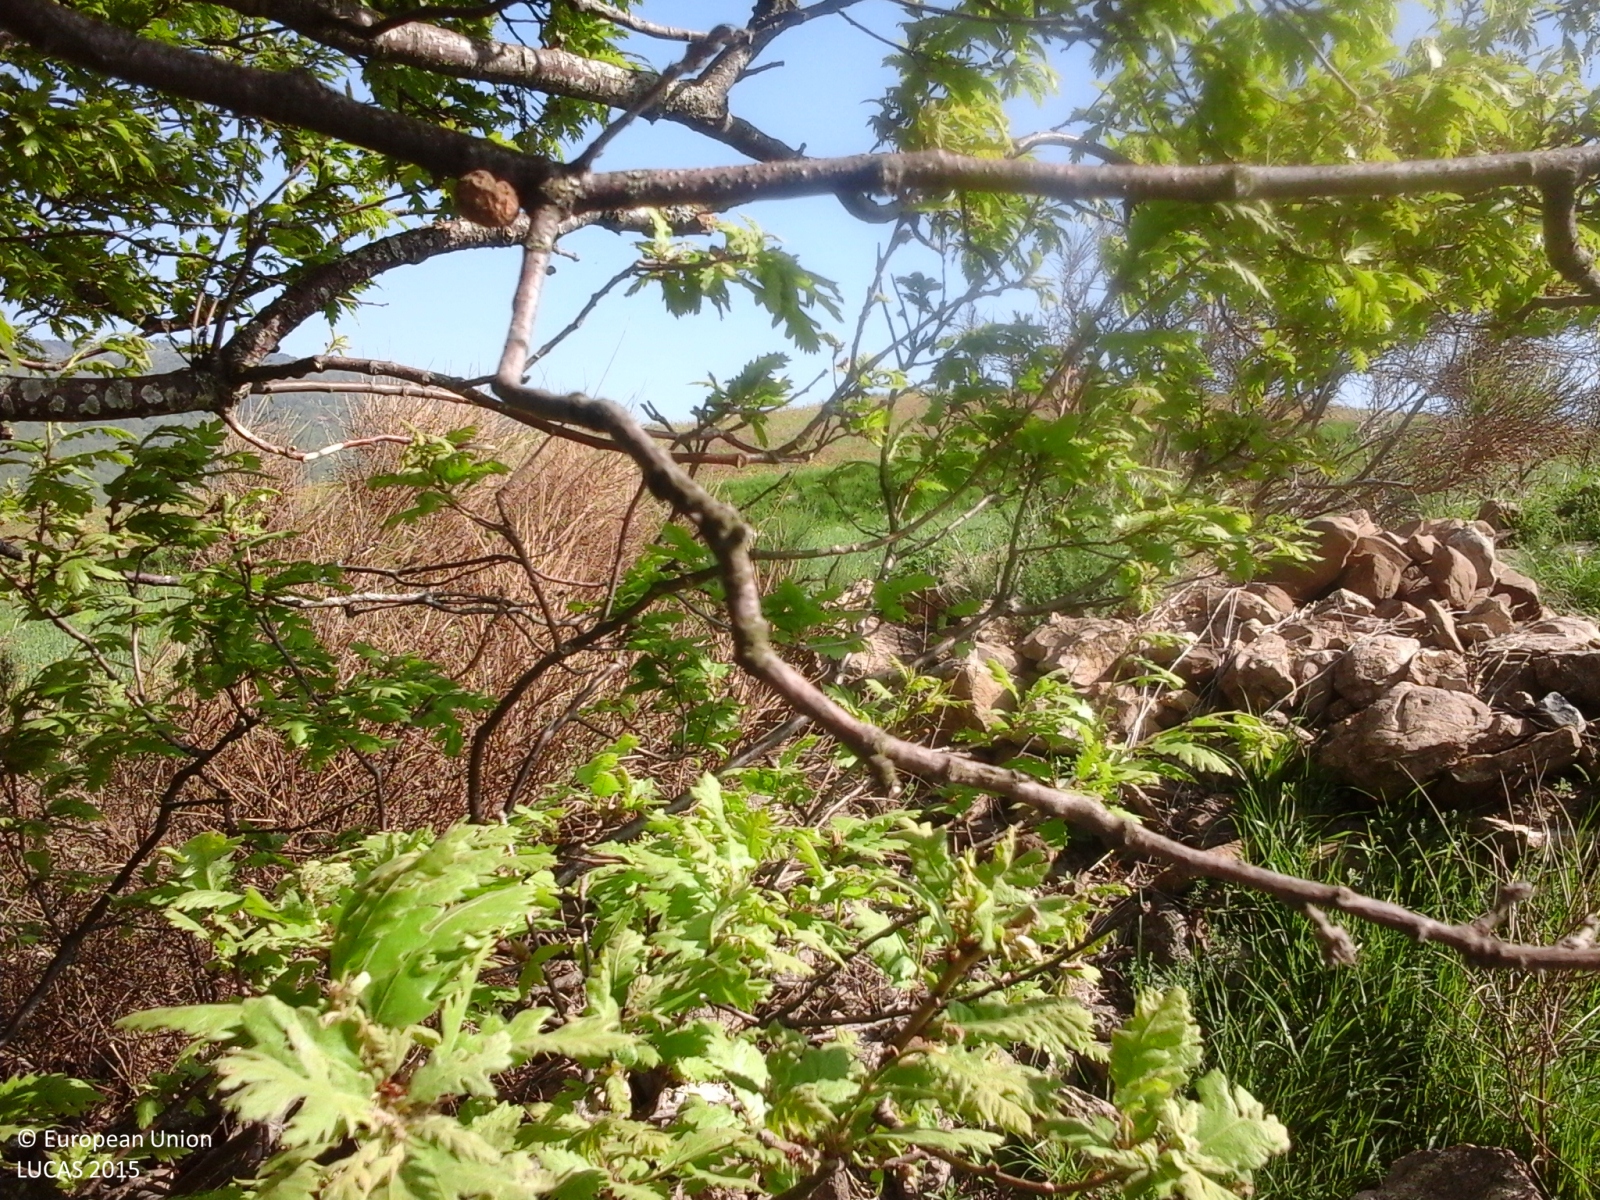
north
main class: Woodland
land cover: Broadleaved woodland
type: thermophilous deciduous forest
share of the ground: 25 - 50 %
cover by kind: herbaceous plants 50 %, broadleaved forest trees 40 %, shrubs 10 %
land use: Agriculture (excluding fallow land and kitchen gardens)
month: May
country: IT
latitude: 41.2803
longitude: 14.6510
